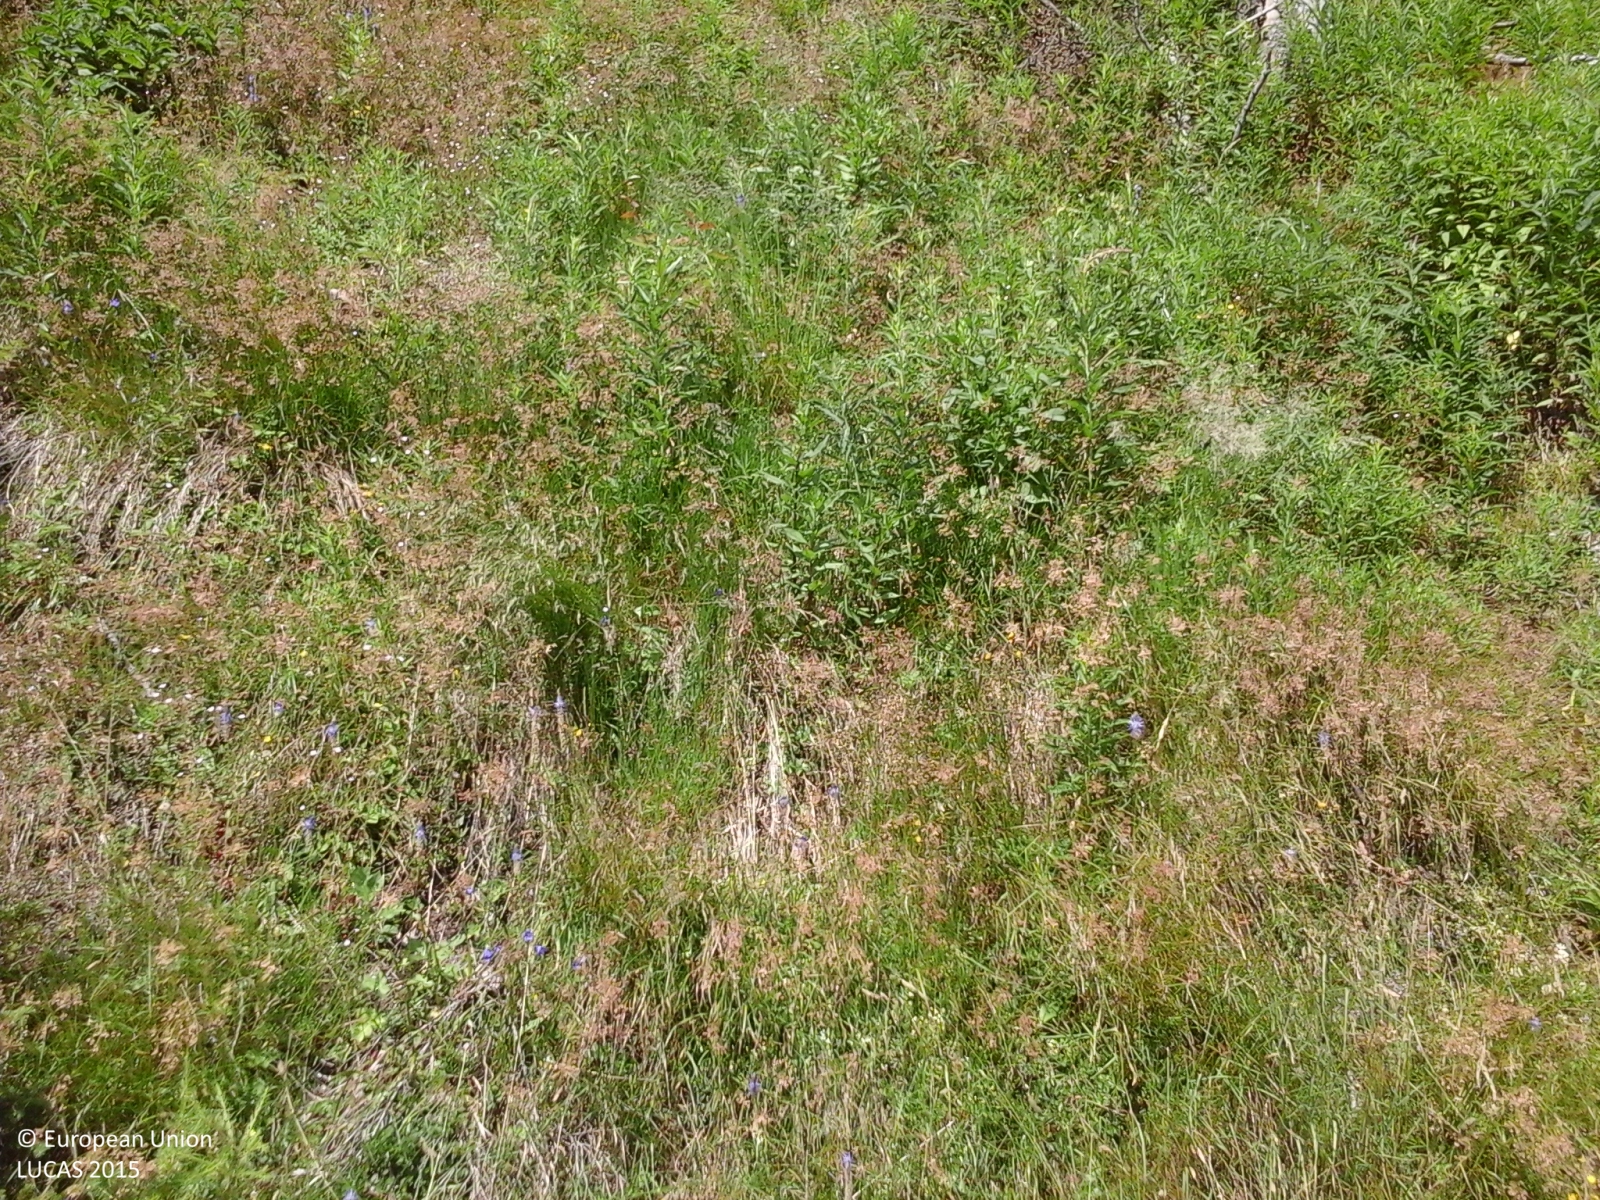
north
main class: Woodland
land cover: Spruce dominated coniferous woodland
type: alpine coniferous forest
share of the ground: > 75 %
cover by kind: coniferous forest trees 100 %
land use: Semi-natural and natural areas not in use
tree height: > 5 m
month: July
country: IT
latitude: 46.8438
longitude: 11.5850
